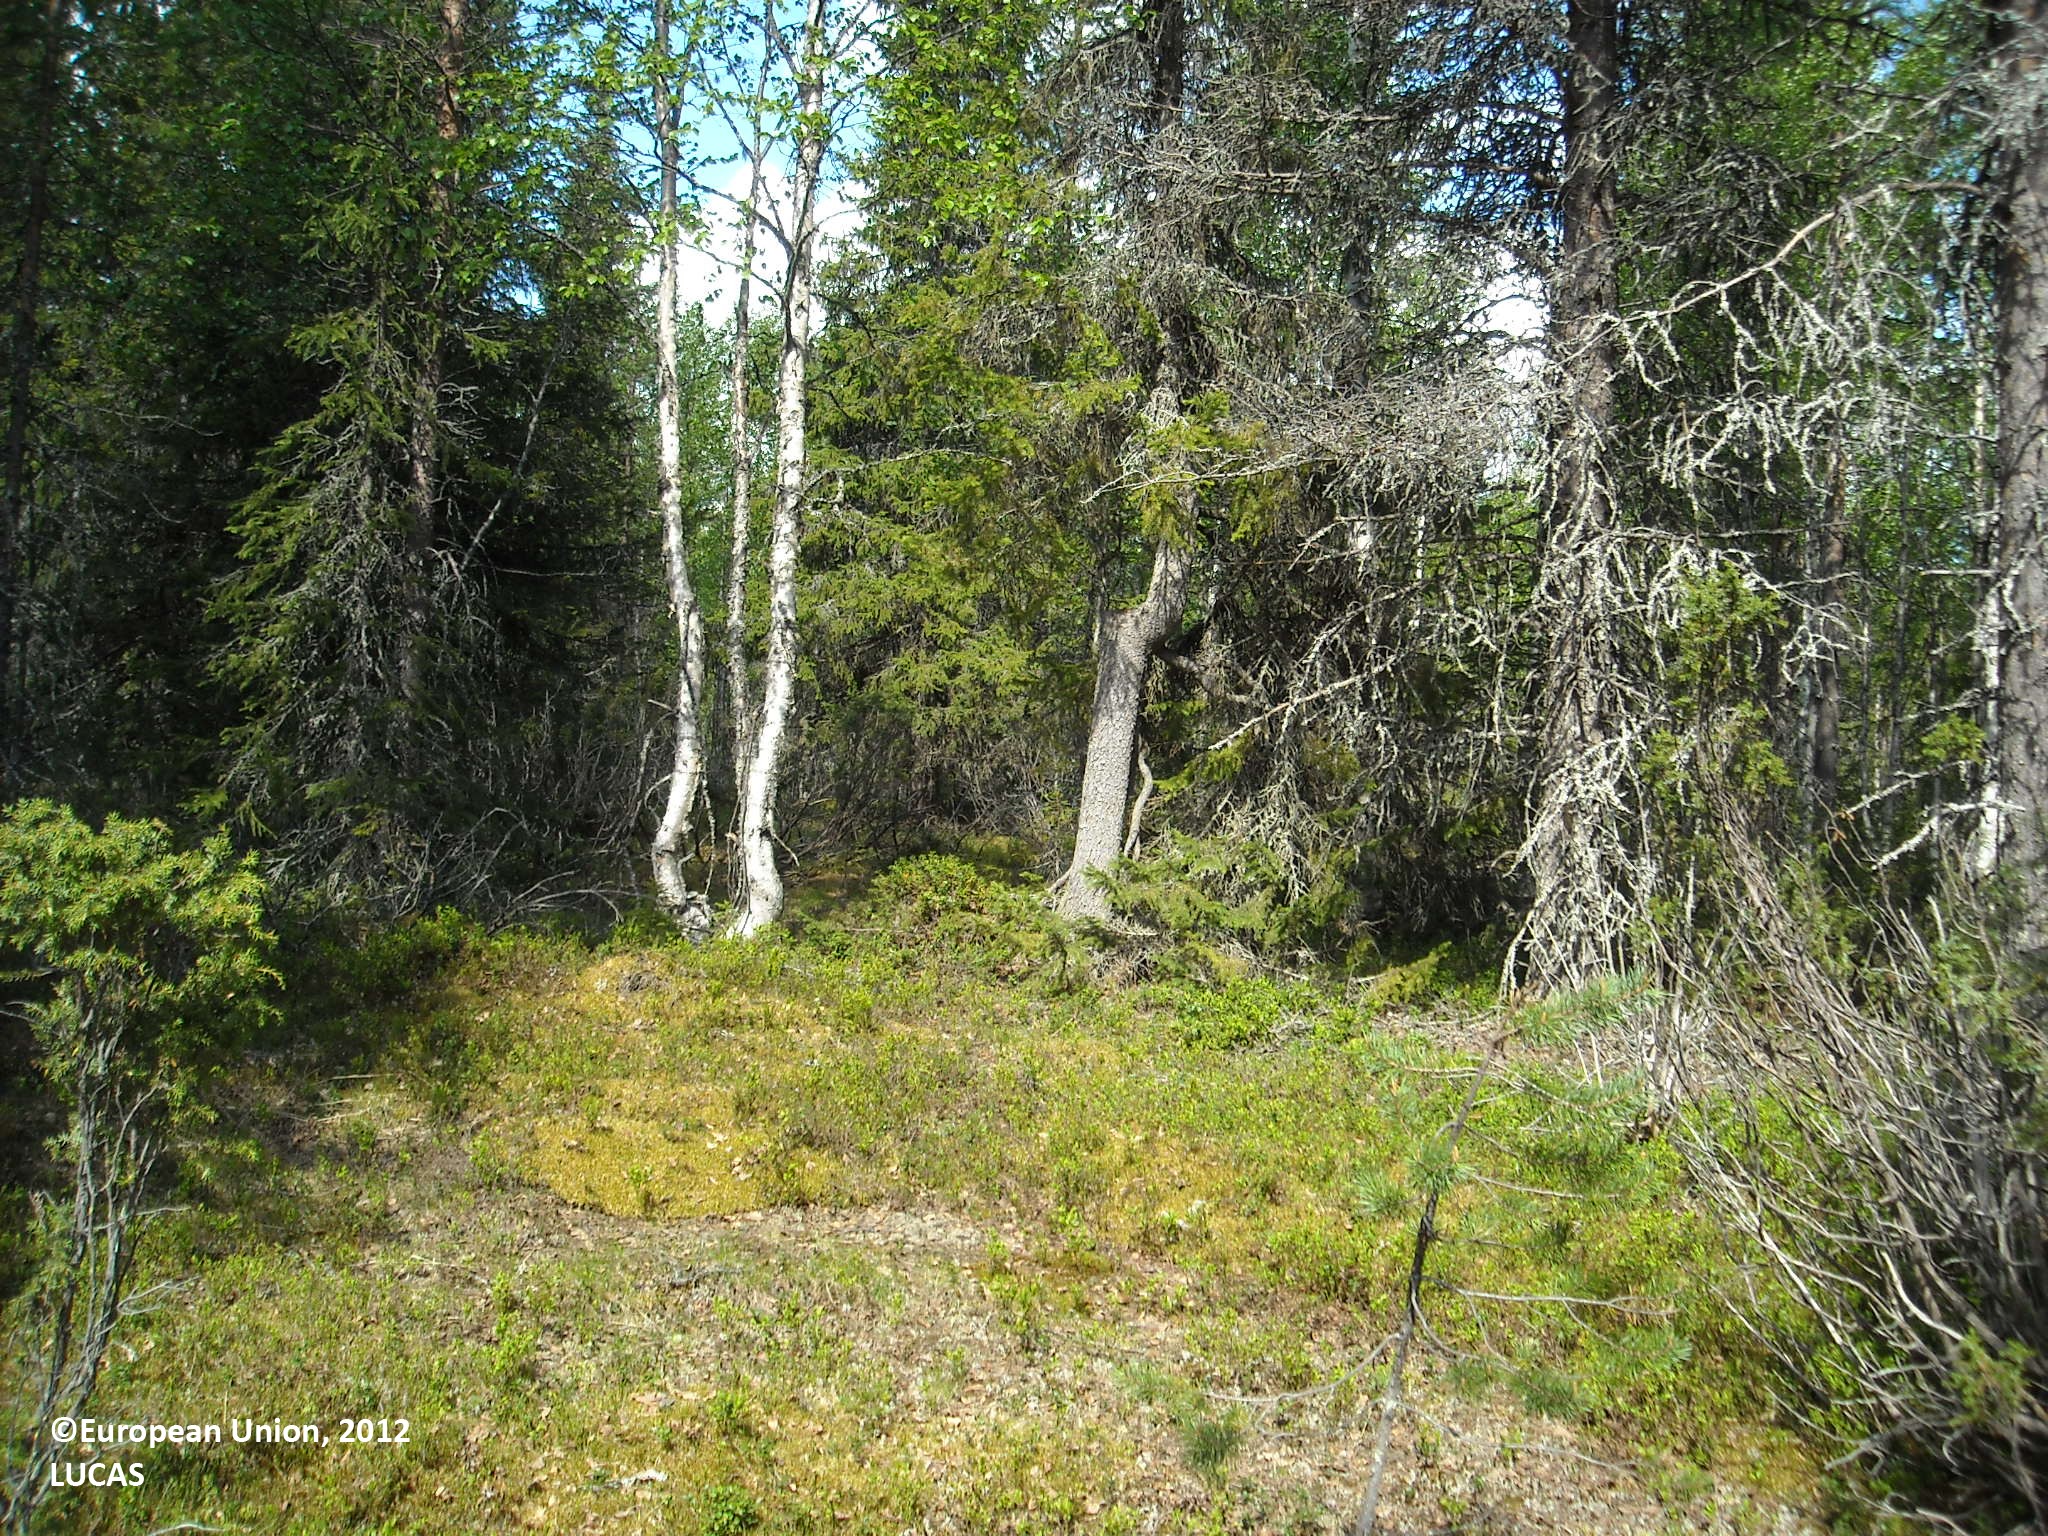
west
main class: Woodland
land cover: Other mixed woodland
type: boreal forest
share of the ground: > 75 %
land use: Forestry
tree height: > 5 m
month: June
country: FI
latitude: 65.7470
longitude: 27.9650
